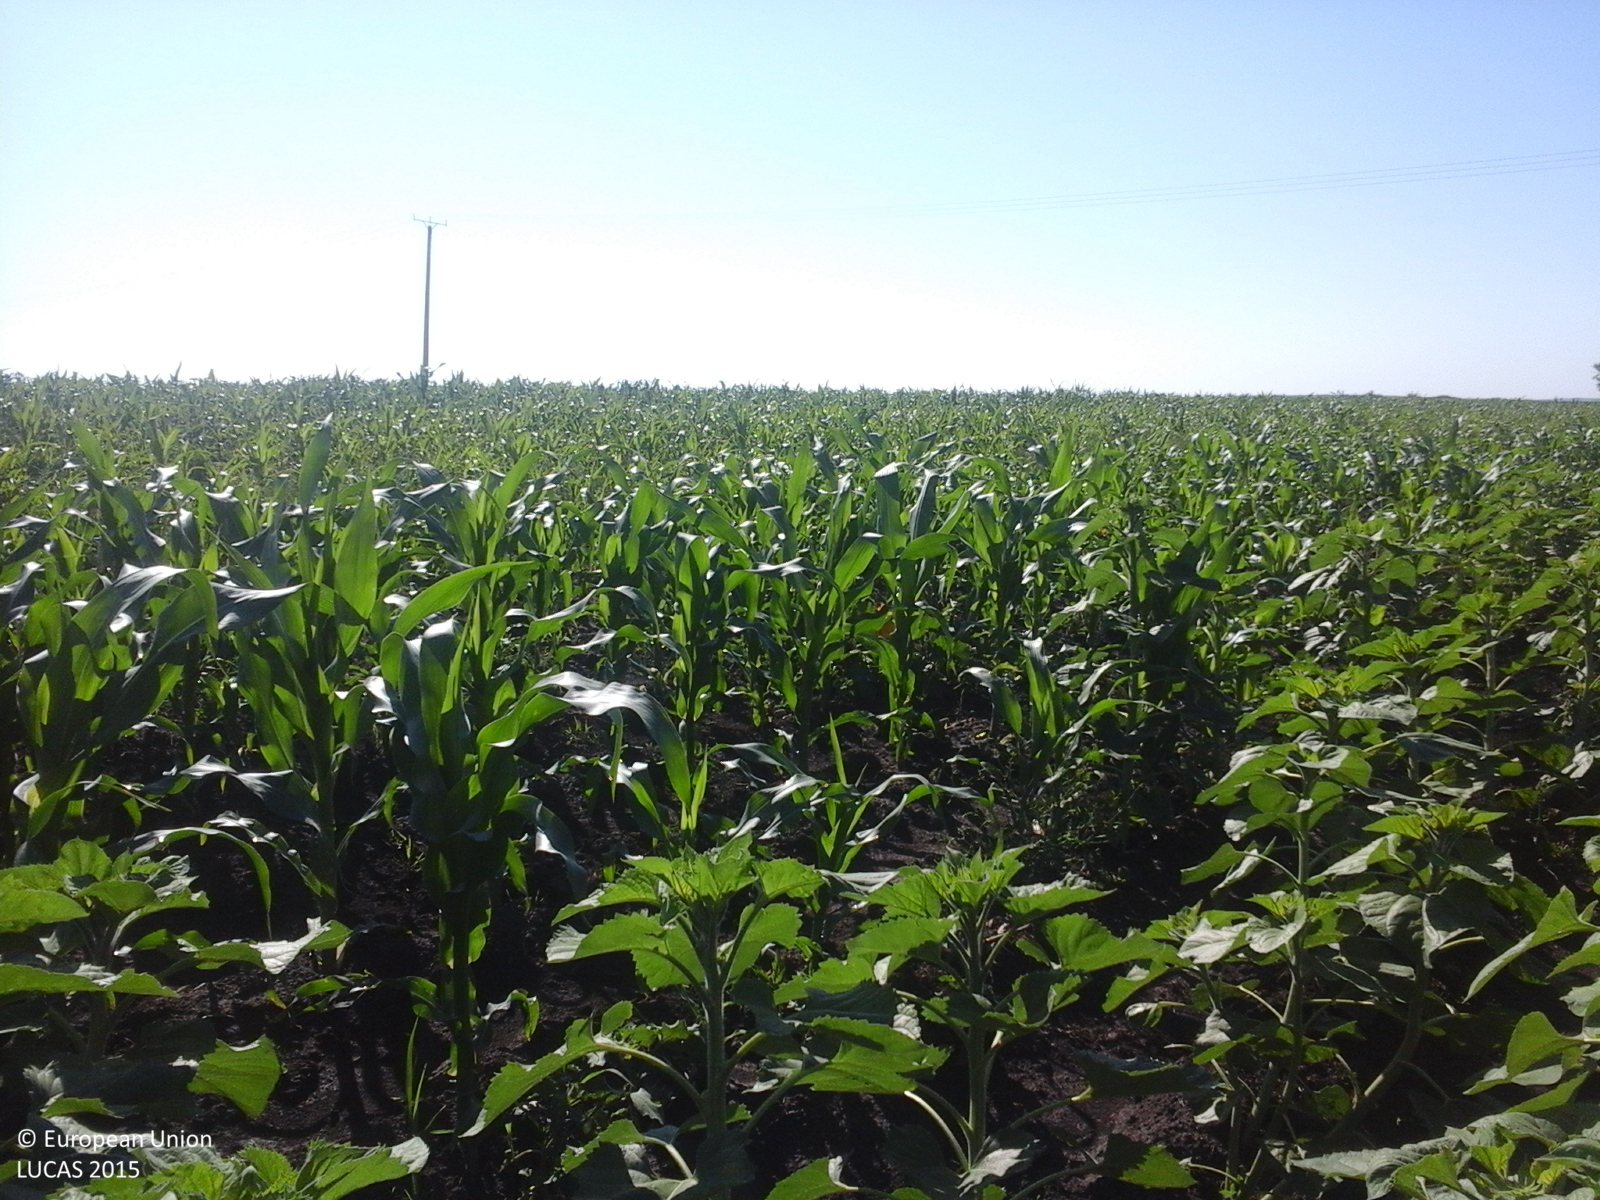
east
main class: Cropland
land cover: Sunflower
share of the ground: 50 - 75 %
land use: Agriculture (excluding fallow land and kitchen gardens)
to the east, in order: Sunflower; Maize; Other fresh vegetables; Maize; Soya; Electric lines; Soya; Grass margins; Tracks; Soya
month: June
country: RO
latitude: 47.7020
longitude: 27.0984
